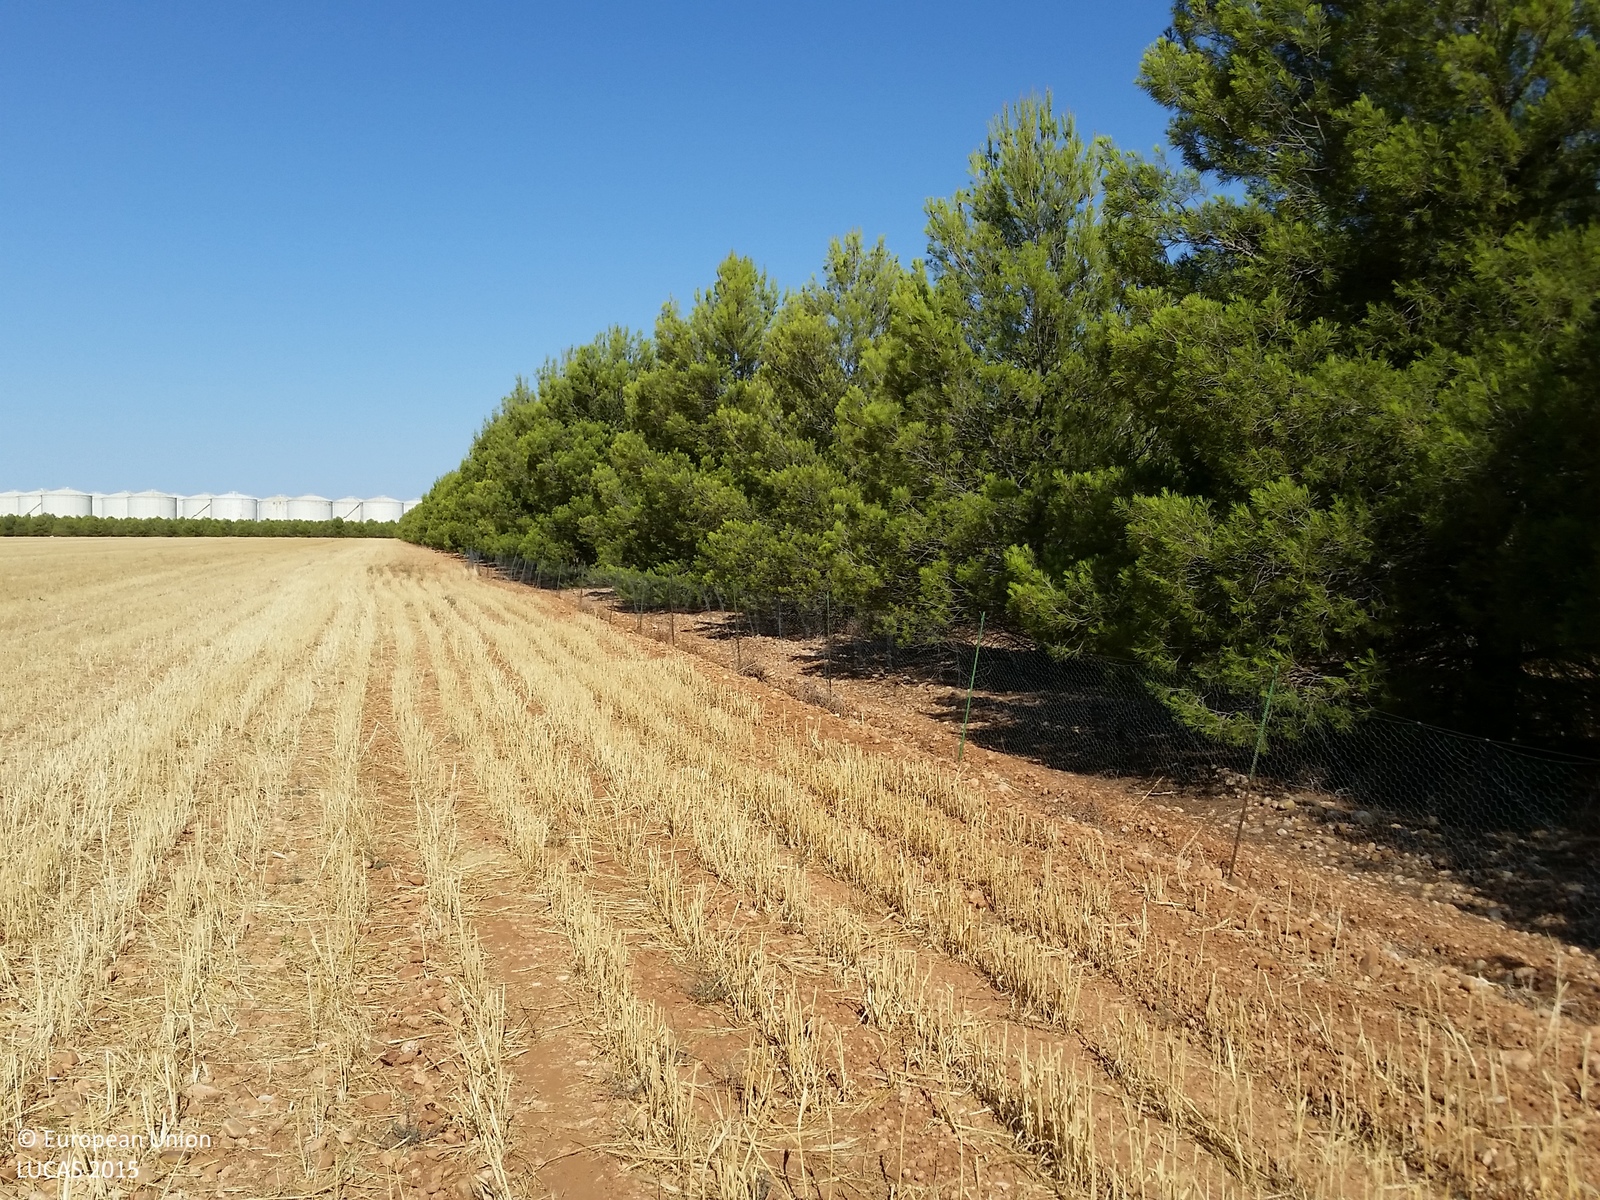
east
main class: Cropland
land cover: Barley
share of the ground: < 10 %
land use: Agriculture (excluding fallow land and kitchen gardens)
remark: Harvested field
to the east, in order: Barley; Fences; Pine dominated coniferous woodland
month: July
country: ES
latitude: 39.2197
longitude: -2.6932
